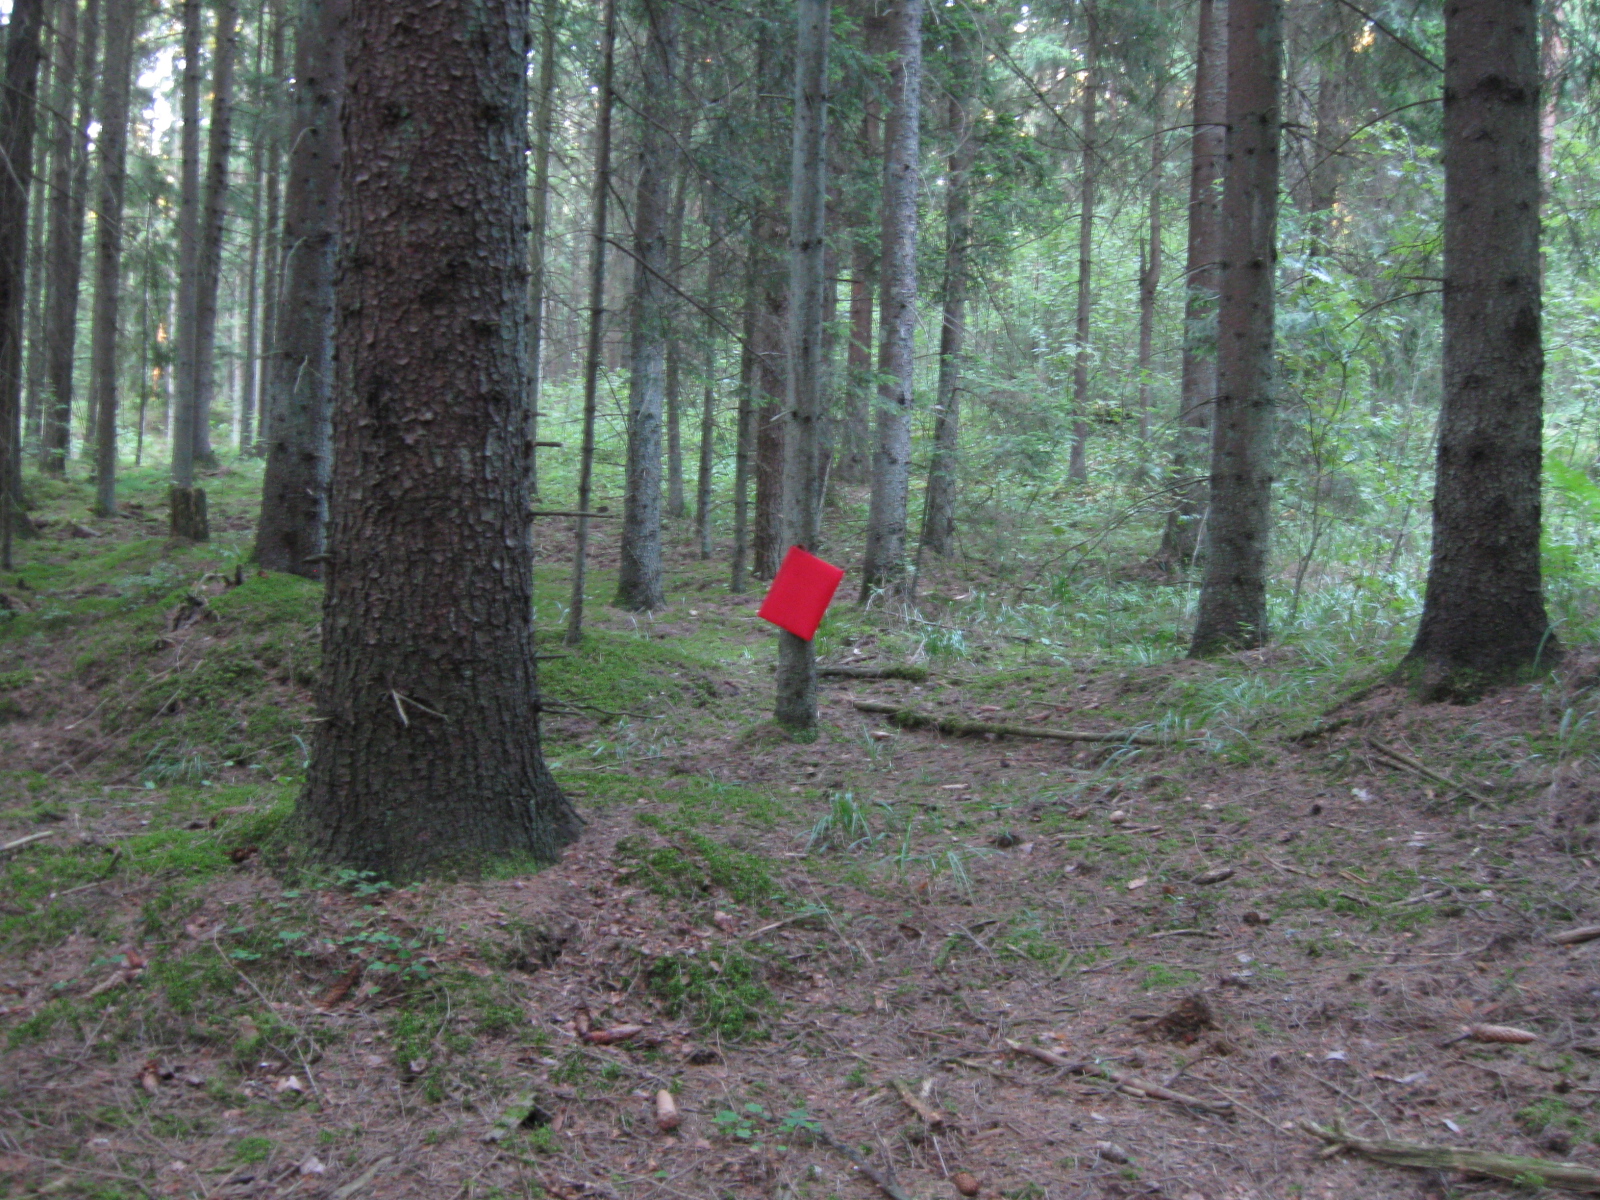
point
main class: Woodland
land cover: Spruce dominated coniferous woodland
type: hemiboreal forest and nemoral coniferous forest and mixed broadleaved-coniferous forest
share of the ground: > 75 %
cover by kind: coniferous forest trees 80 %, lichens and mosses 10 %, herbaceous plants 5 %, unconsolidated bare surface 5 %
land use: Forestry
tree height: > 5 m
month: August
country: LT
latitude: 54.7831
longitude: 23.4367
